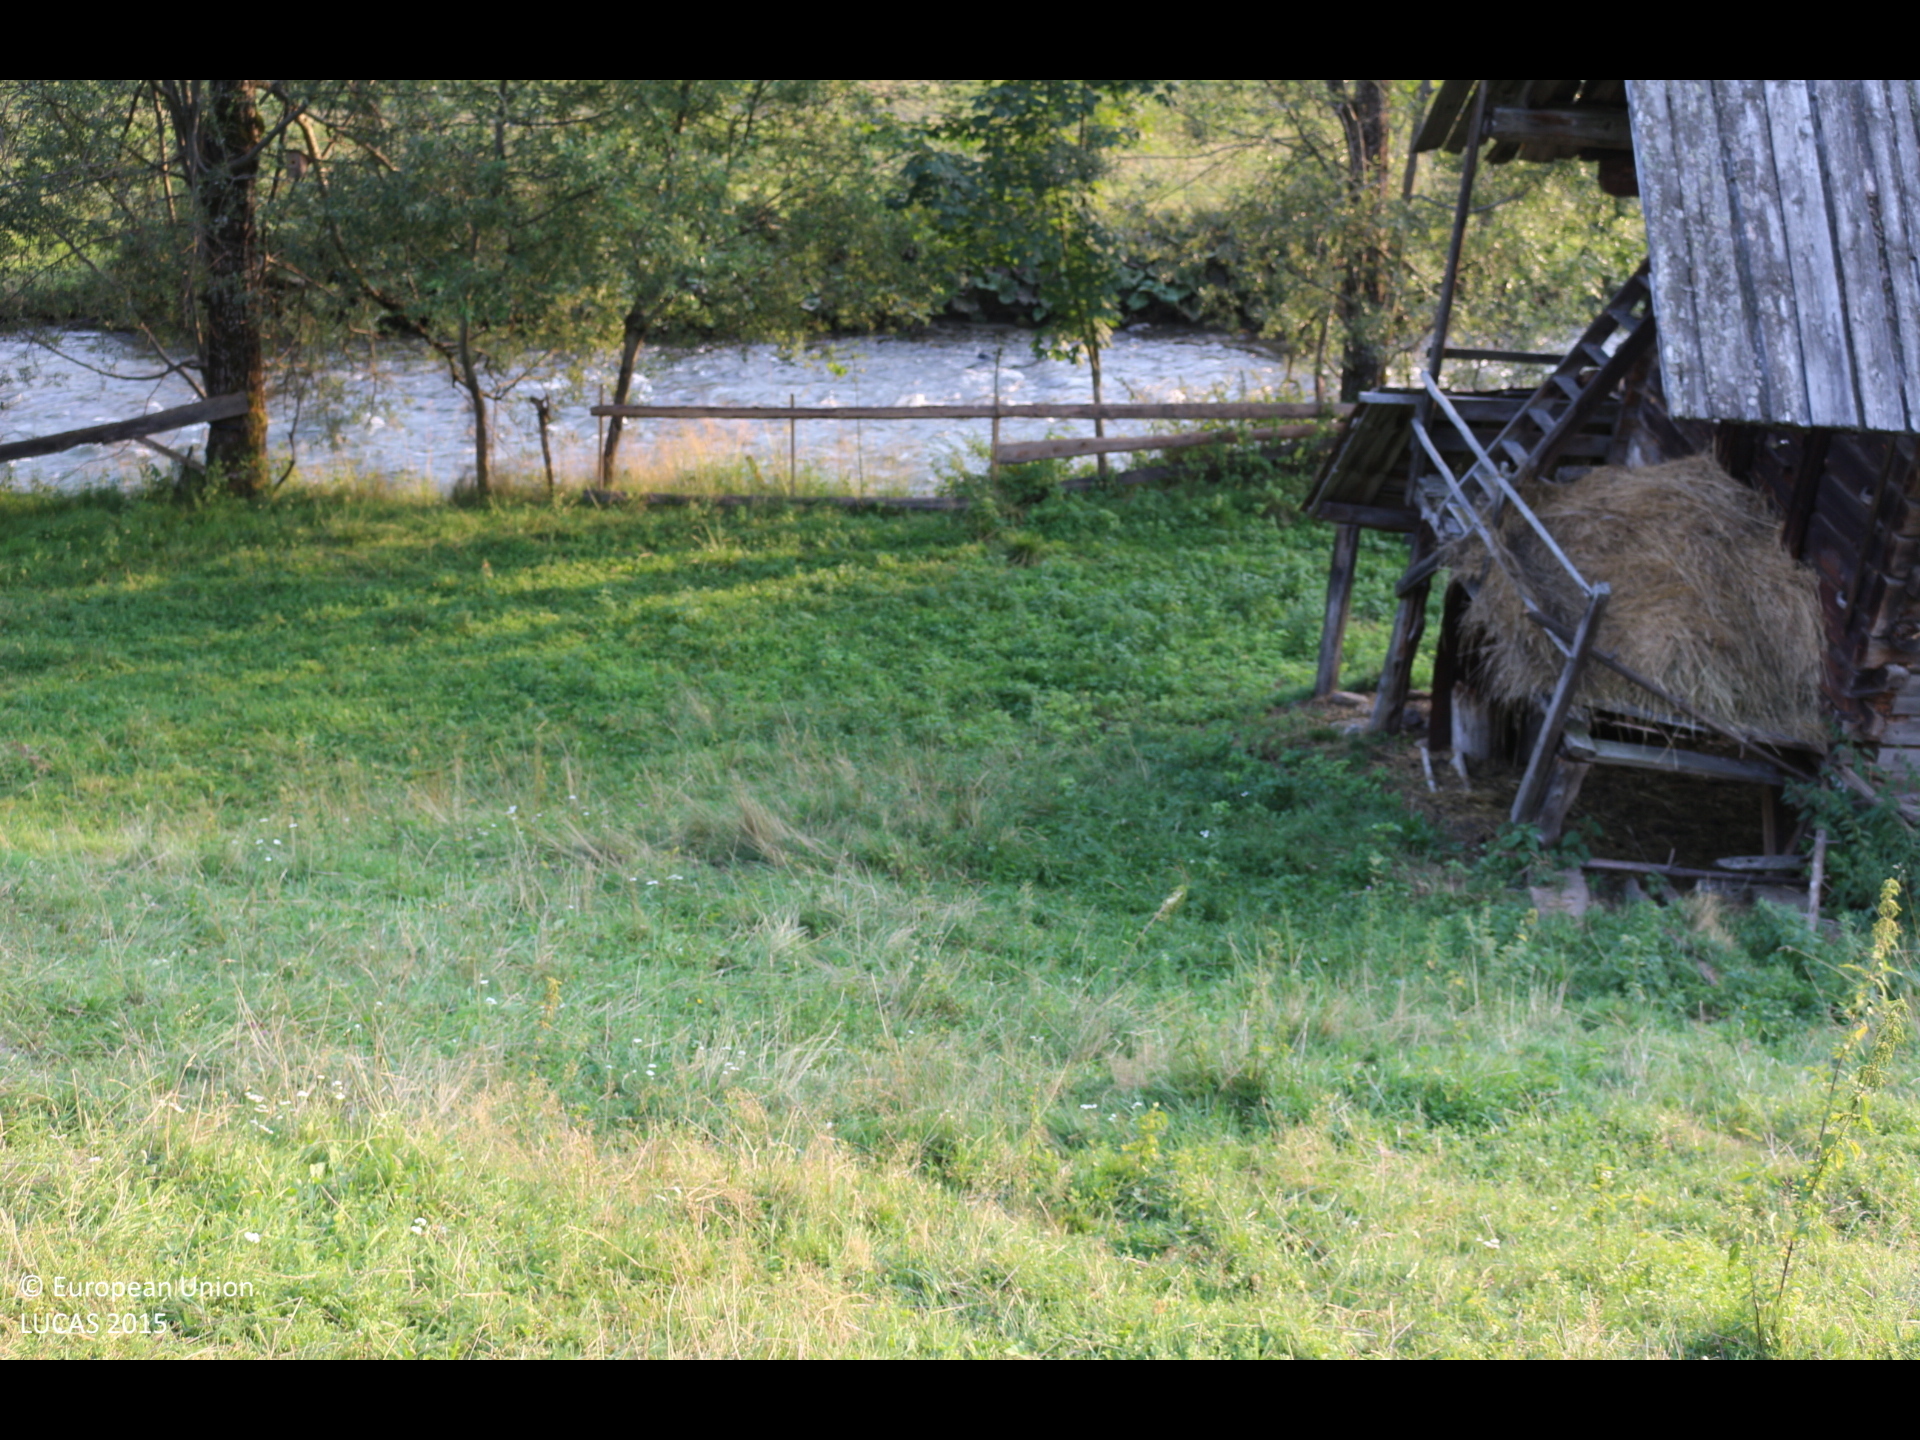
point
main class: Grassland
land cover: Grassland without tree/shrub cover
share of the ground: > 75 %
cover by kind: herbaceous plants 100 %
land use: Agriculture (excluding fallow land and kitchen gardens)
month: August
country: AT
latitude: 46.7835
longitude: 13.9401
